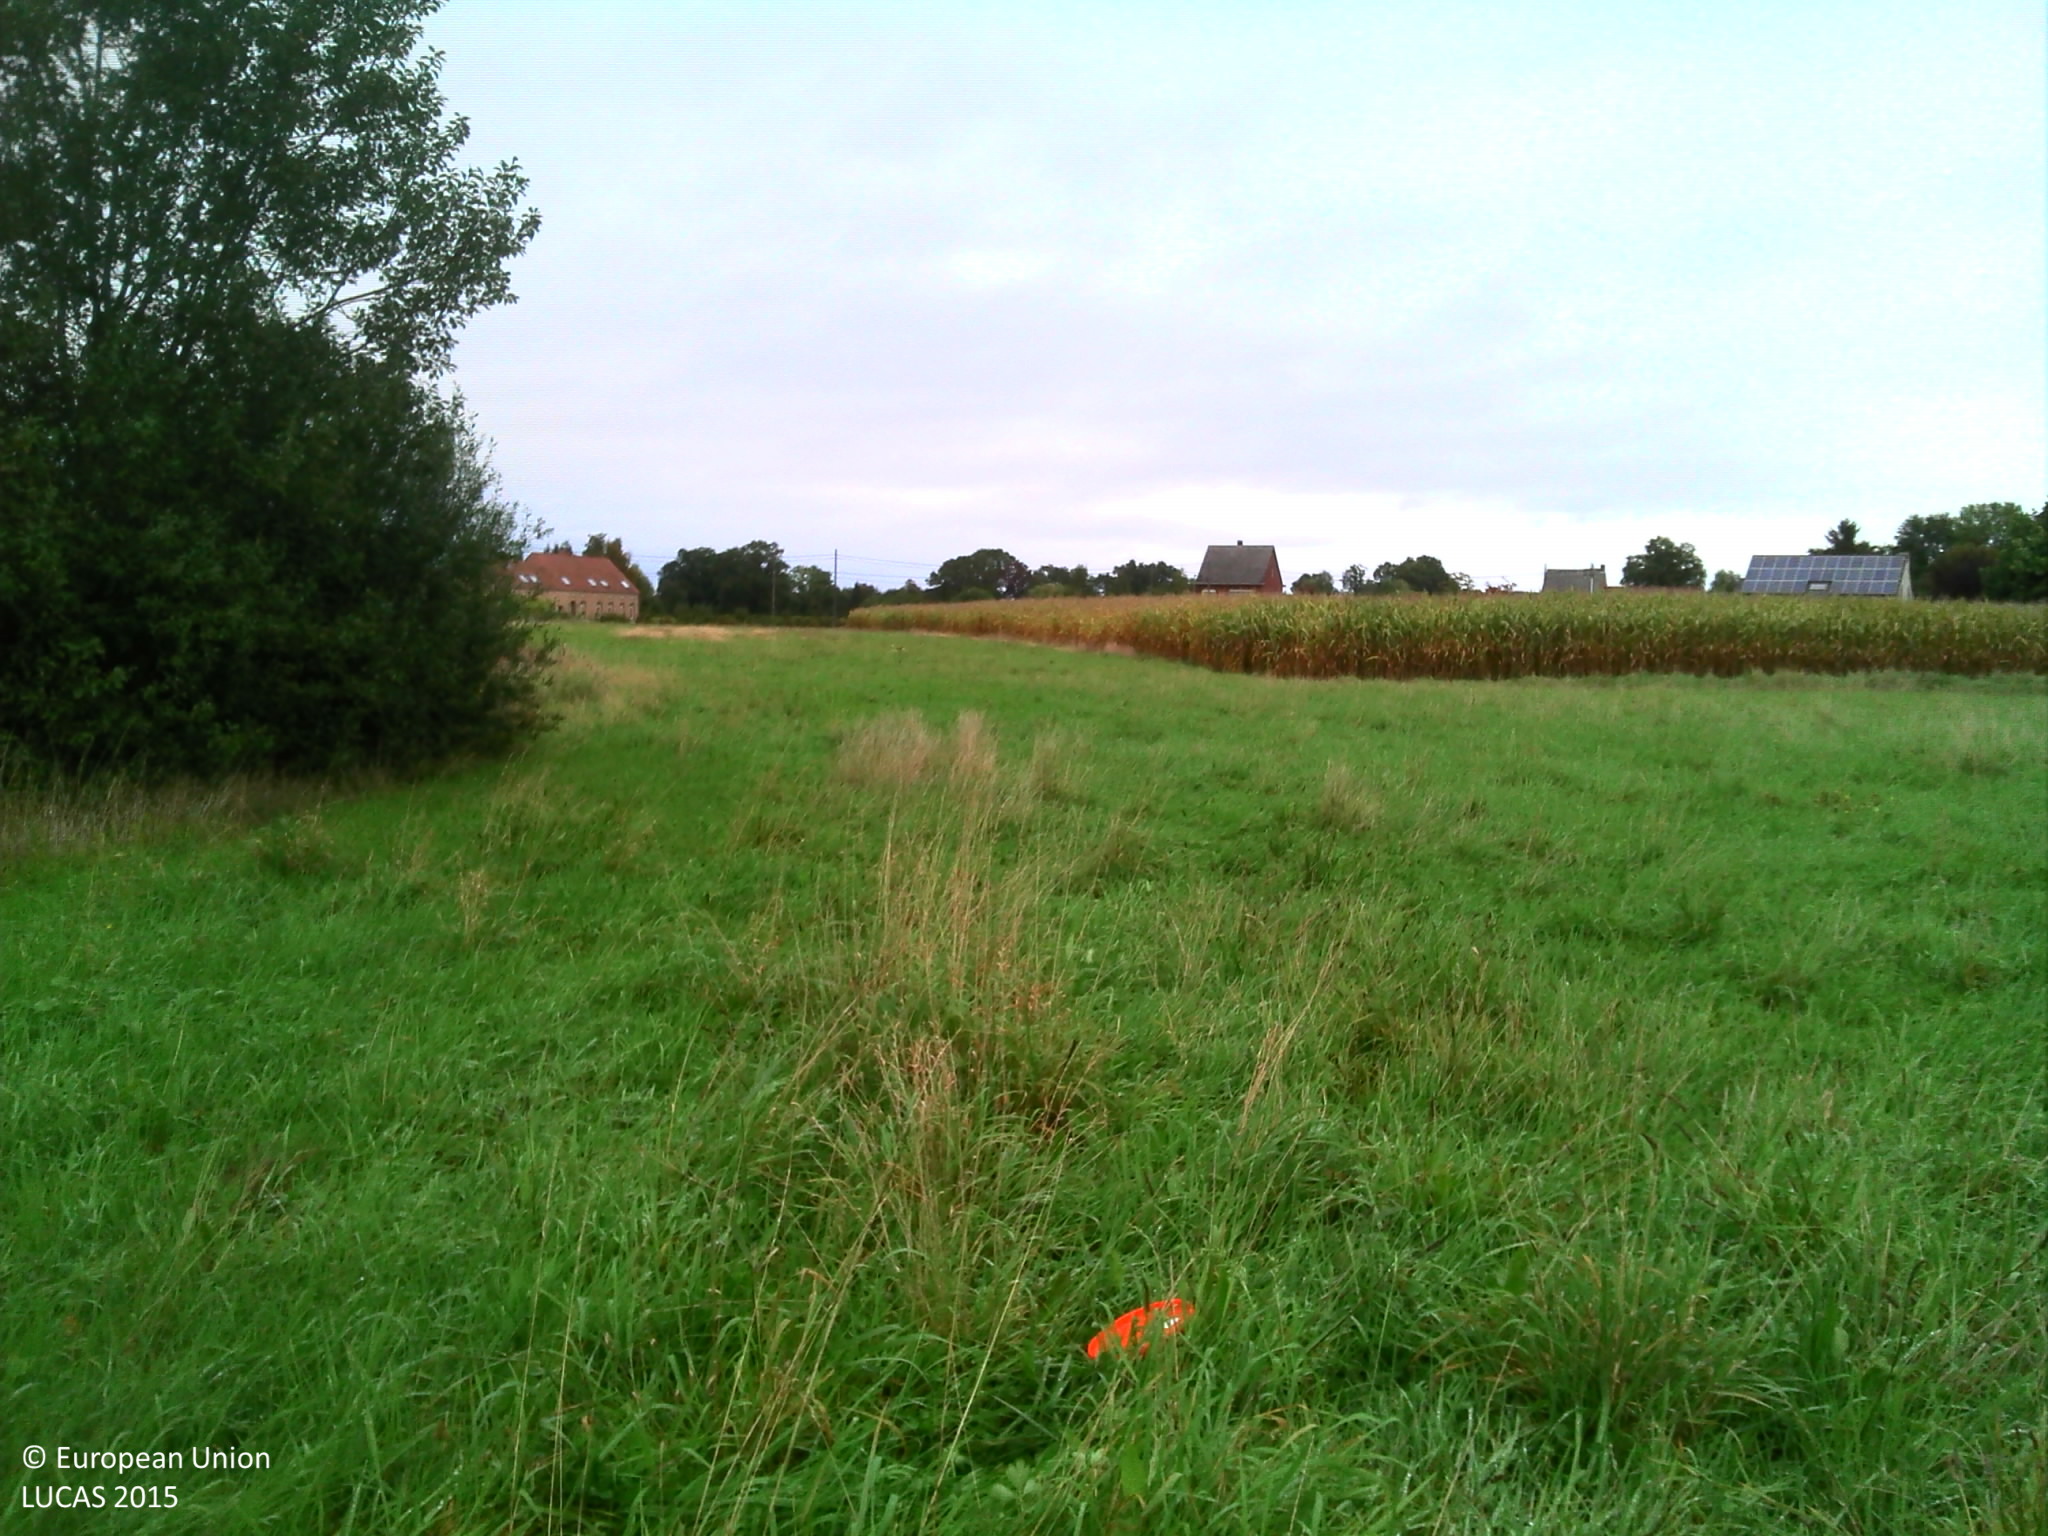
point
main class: Grassland
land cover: Grassland without tree/shrub cover
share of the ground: > 75 %
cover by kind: herbaceous plants 100 %
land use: Agriculture (excluding fallow land and kitchen gardens)
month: October
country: BE
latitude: 51.0549
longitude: 4.7606
